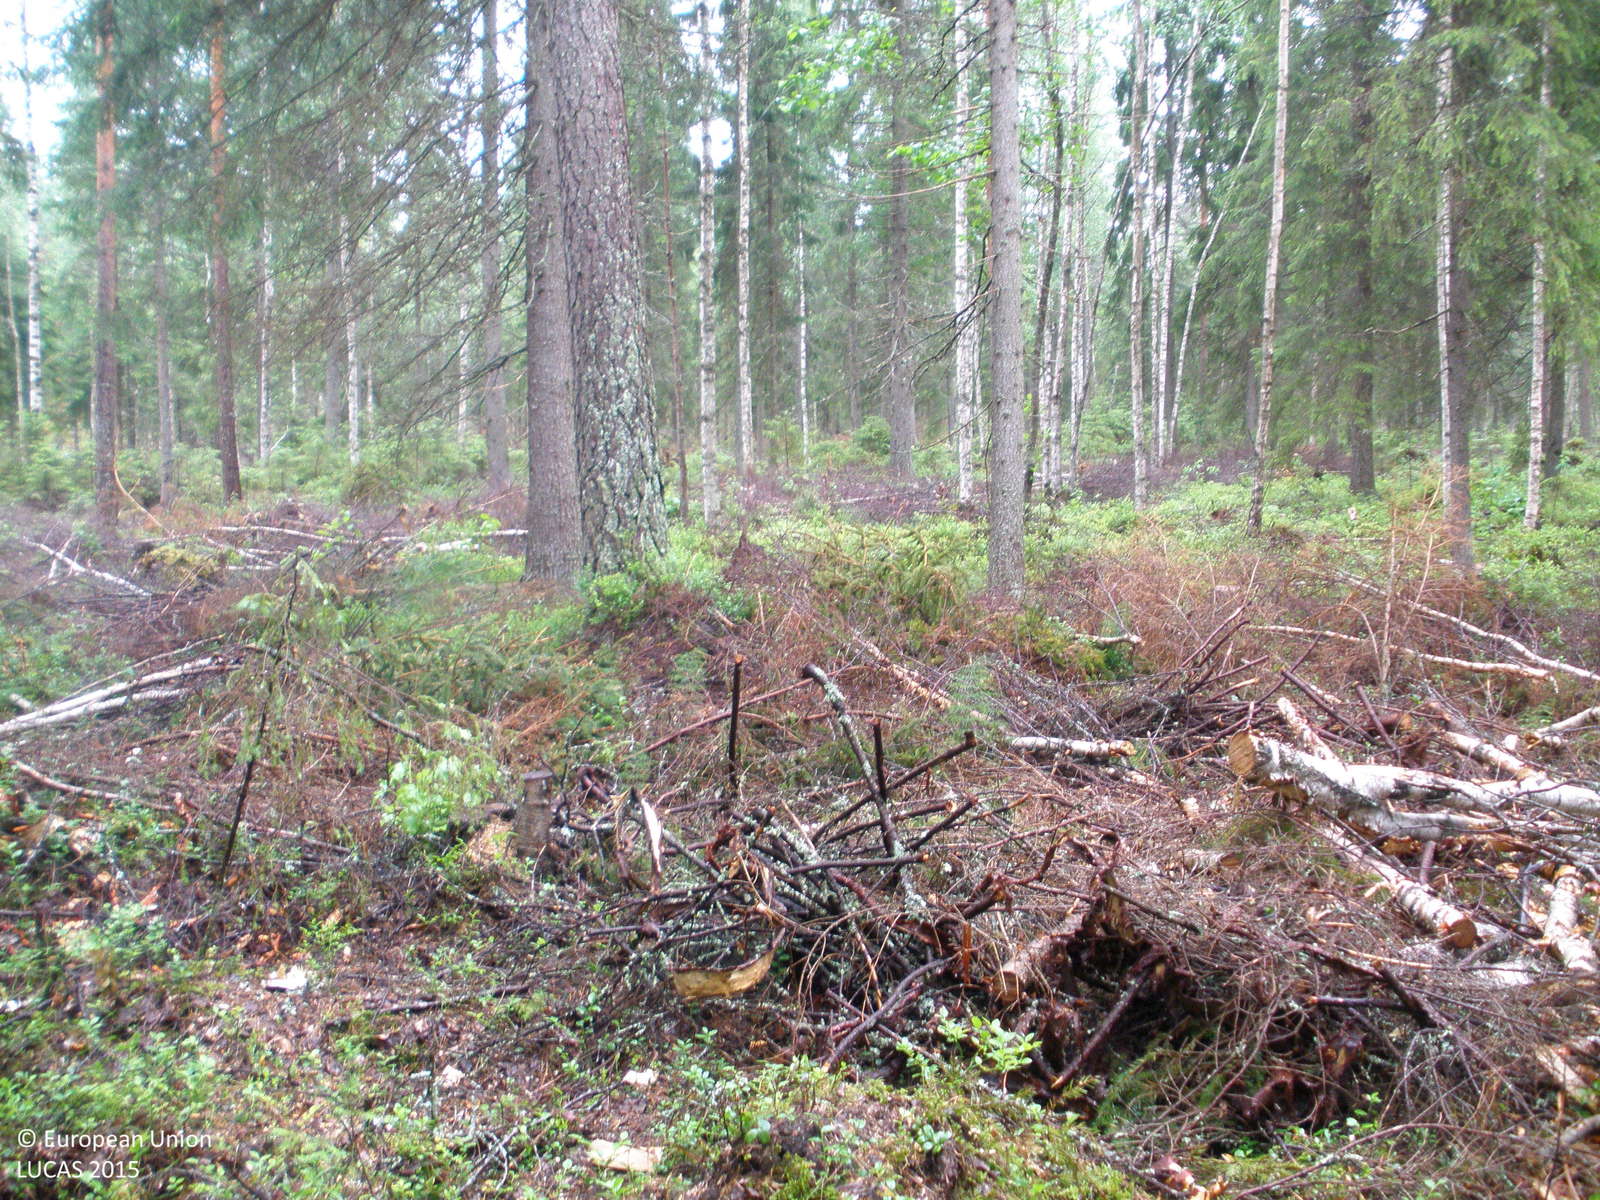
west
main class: Woodland
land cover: Spruce dominated mixed woodland
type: boreal forest
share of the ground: > 75 %
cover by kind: coniferous forest trees 40 %, broadleaved forest trees 35 %, herbaceous plants 15 %, lichens and mosses 5 %
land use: Forestry
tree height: > 5 m
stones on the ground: < 10 %
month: July
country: FI
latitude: 61.3956
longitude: 23.6961
